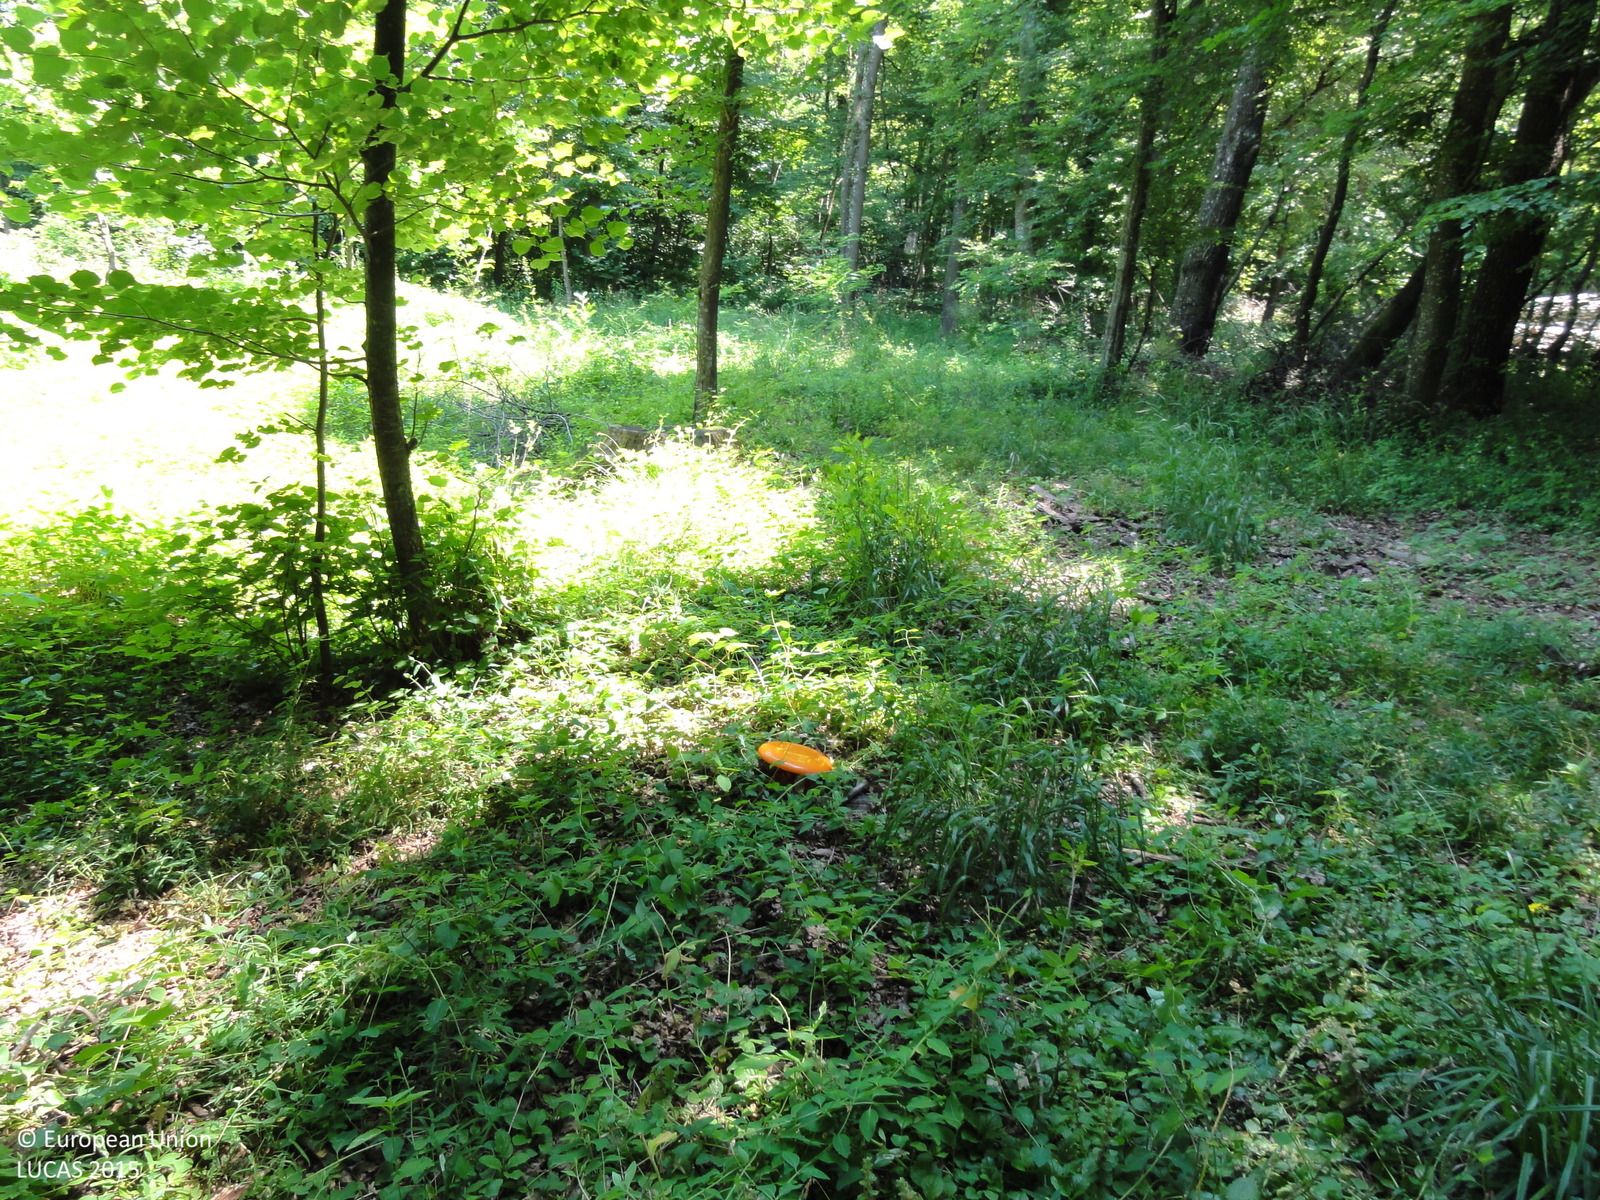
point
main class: Woodland
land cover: Broadleaved woodland
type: mesophytic deciduous forest
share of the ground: 50 - 75 %
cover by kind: broadleaved forest trees 70 %, herbaceous plants 30 %
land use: Forestry
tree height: > 5 m
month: June
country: SI
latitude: 46.6959
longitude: 16.1863
